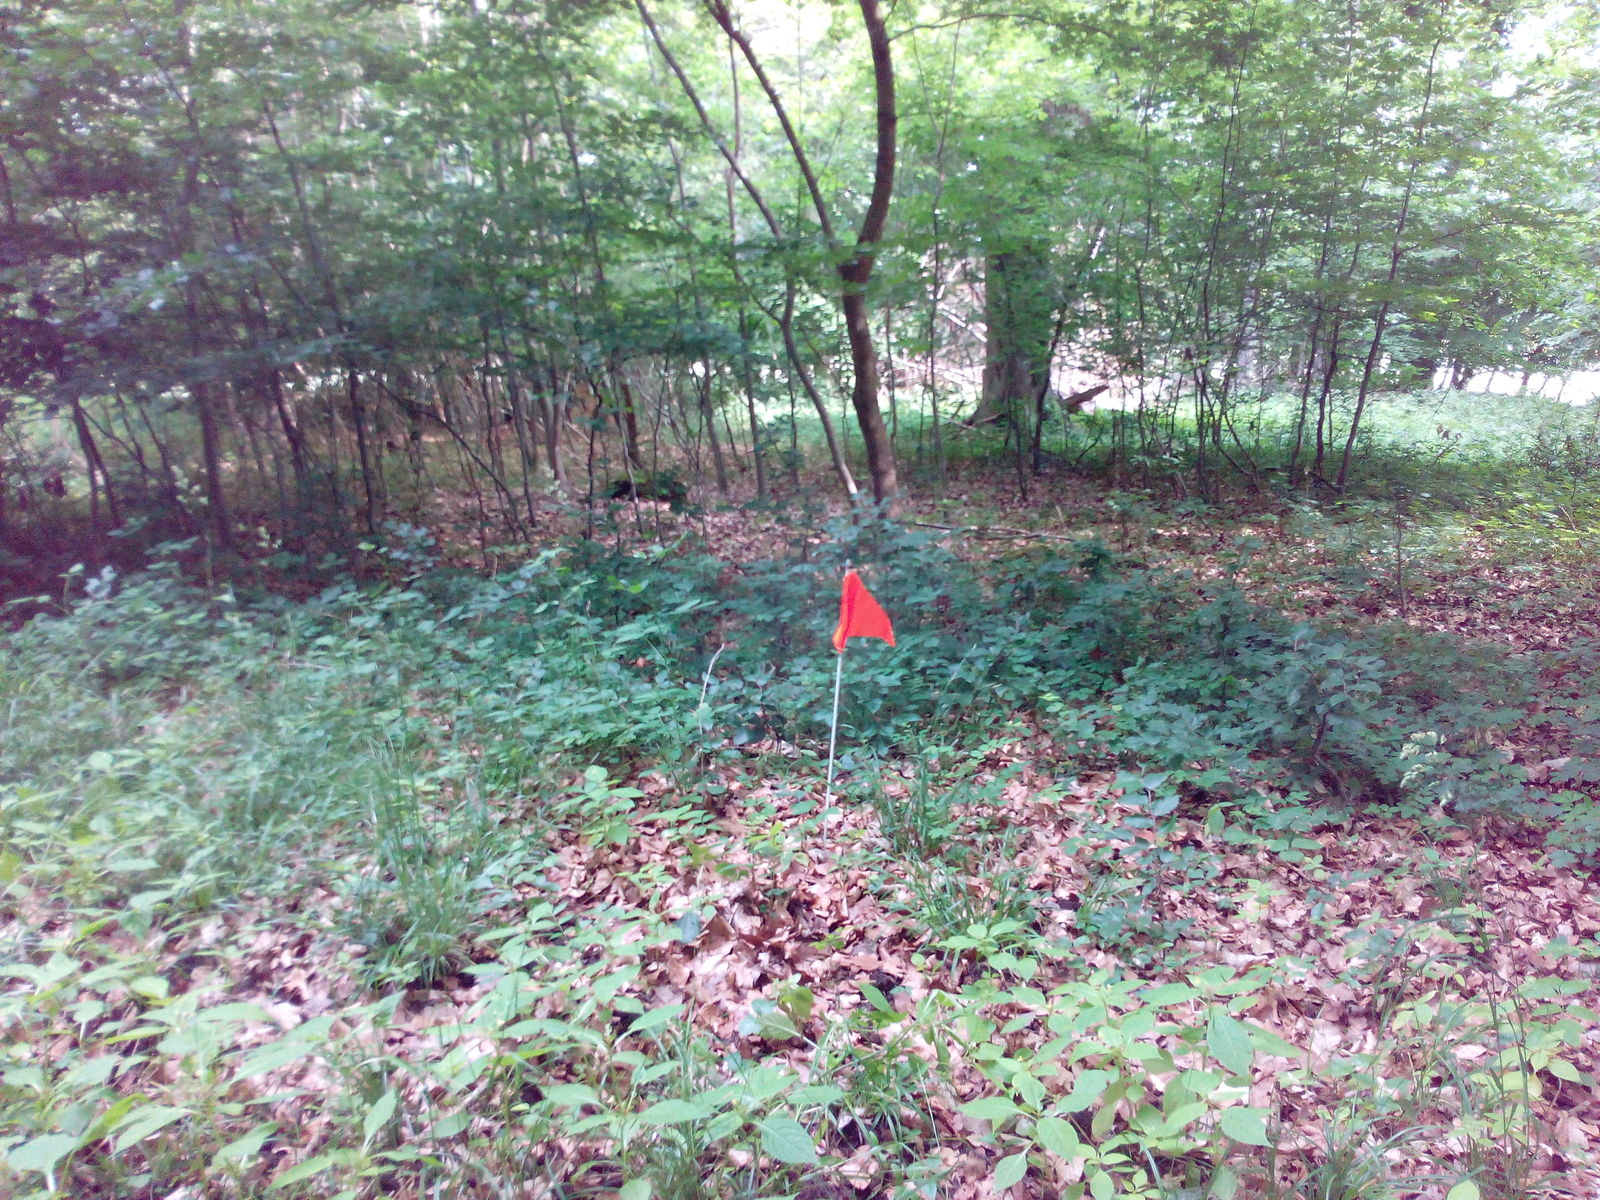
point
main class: Woodland
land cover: Broadleaved woodland
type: beech forest
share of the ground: > 75 %
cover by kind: broadleaved forest trees 90 %, herbaceous plants 10 %
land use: Forestry
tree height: > 5 m
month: June
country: DE
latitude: 51.3304
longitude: 11.0187
